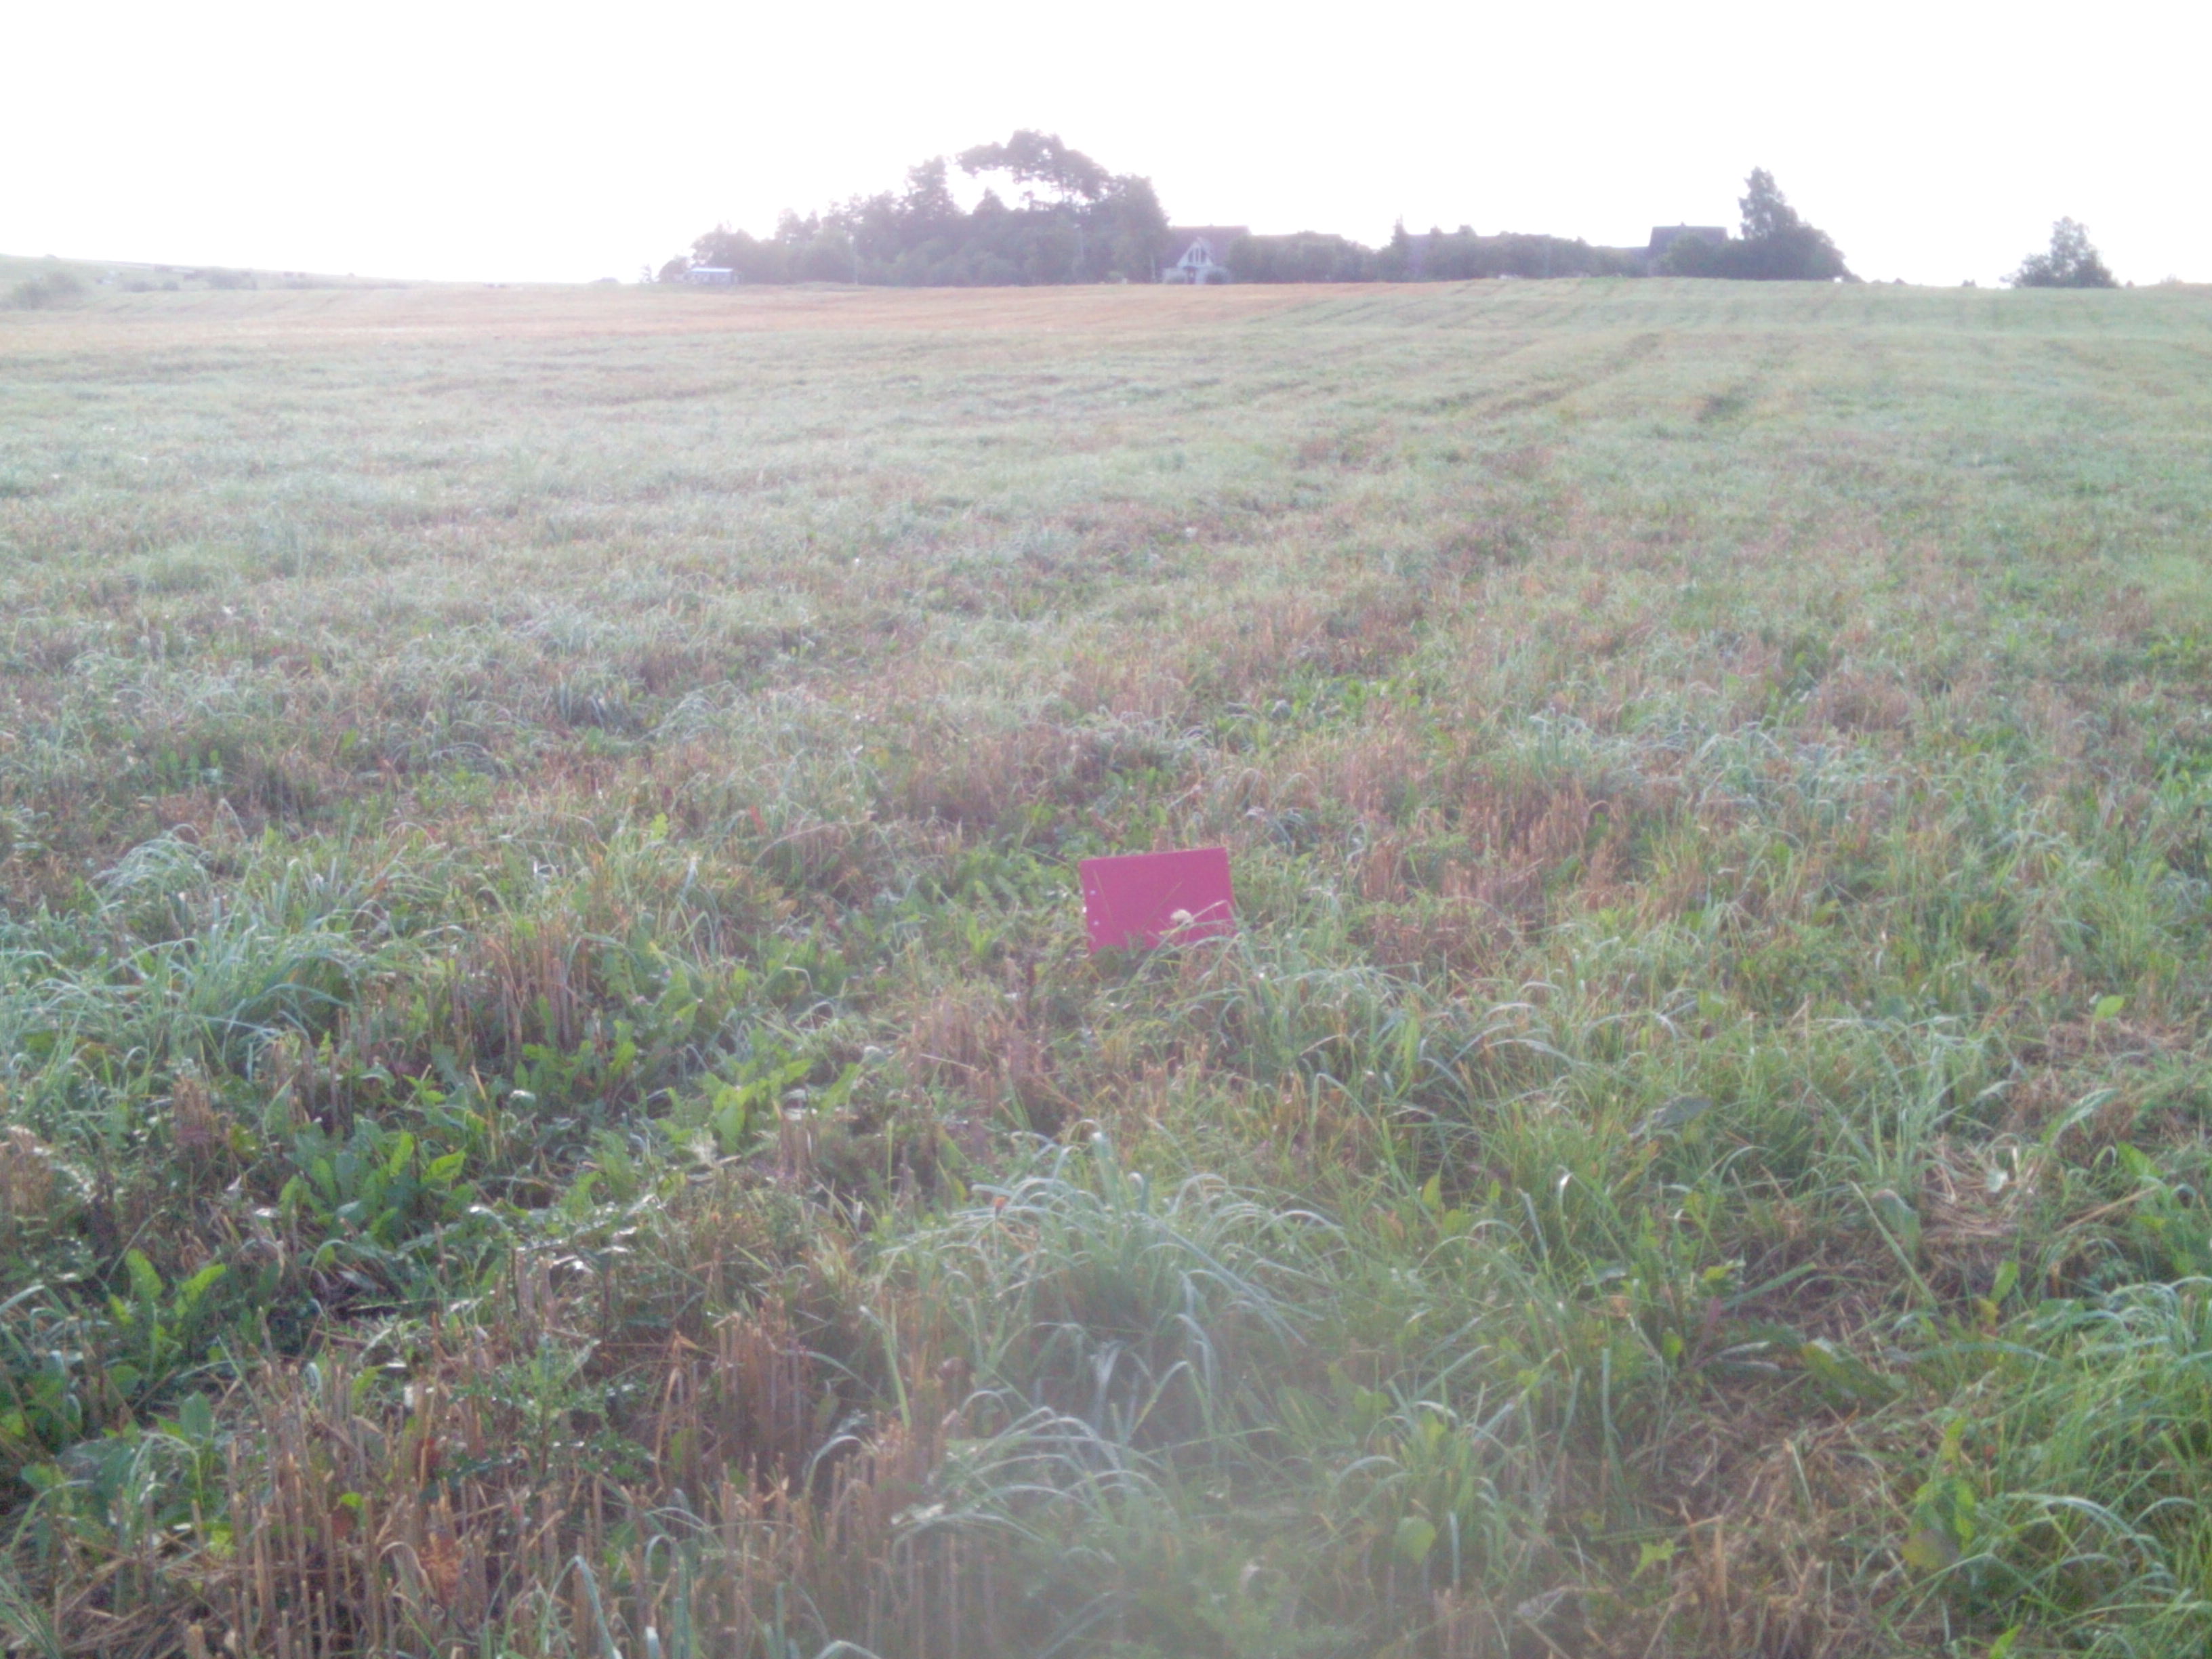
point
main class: Cropland
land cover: Common wheat
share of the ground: > 75 %
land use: Agriculture (excluding fallow land and kitchen gardens)
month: September
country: LT
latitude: 55.7085
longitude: 22.4250
